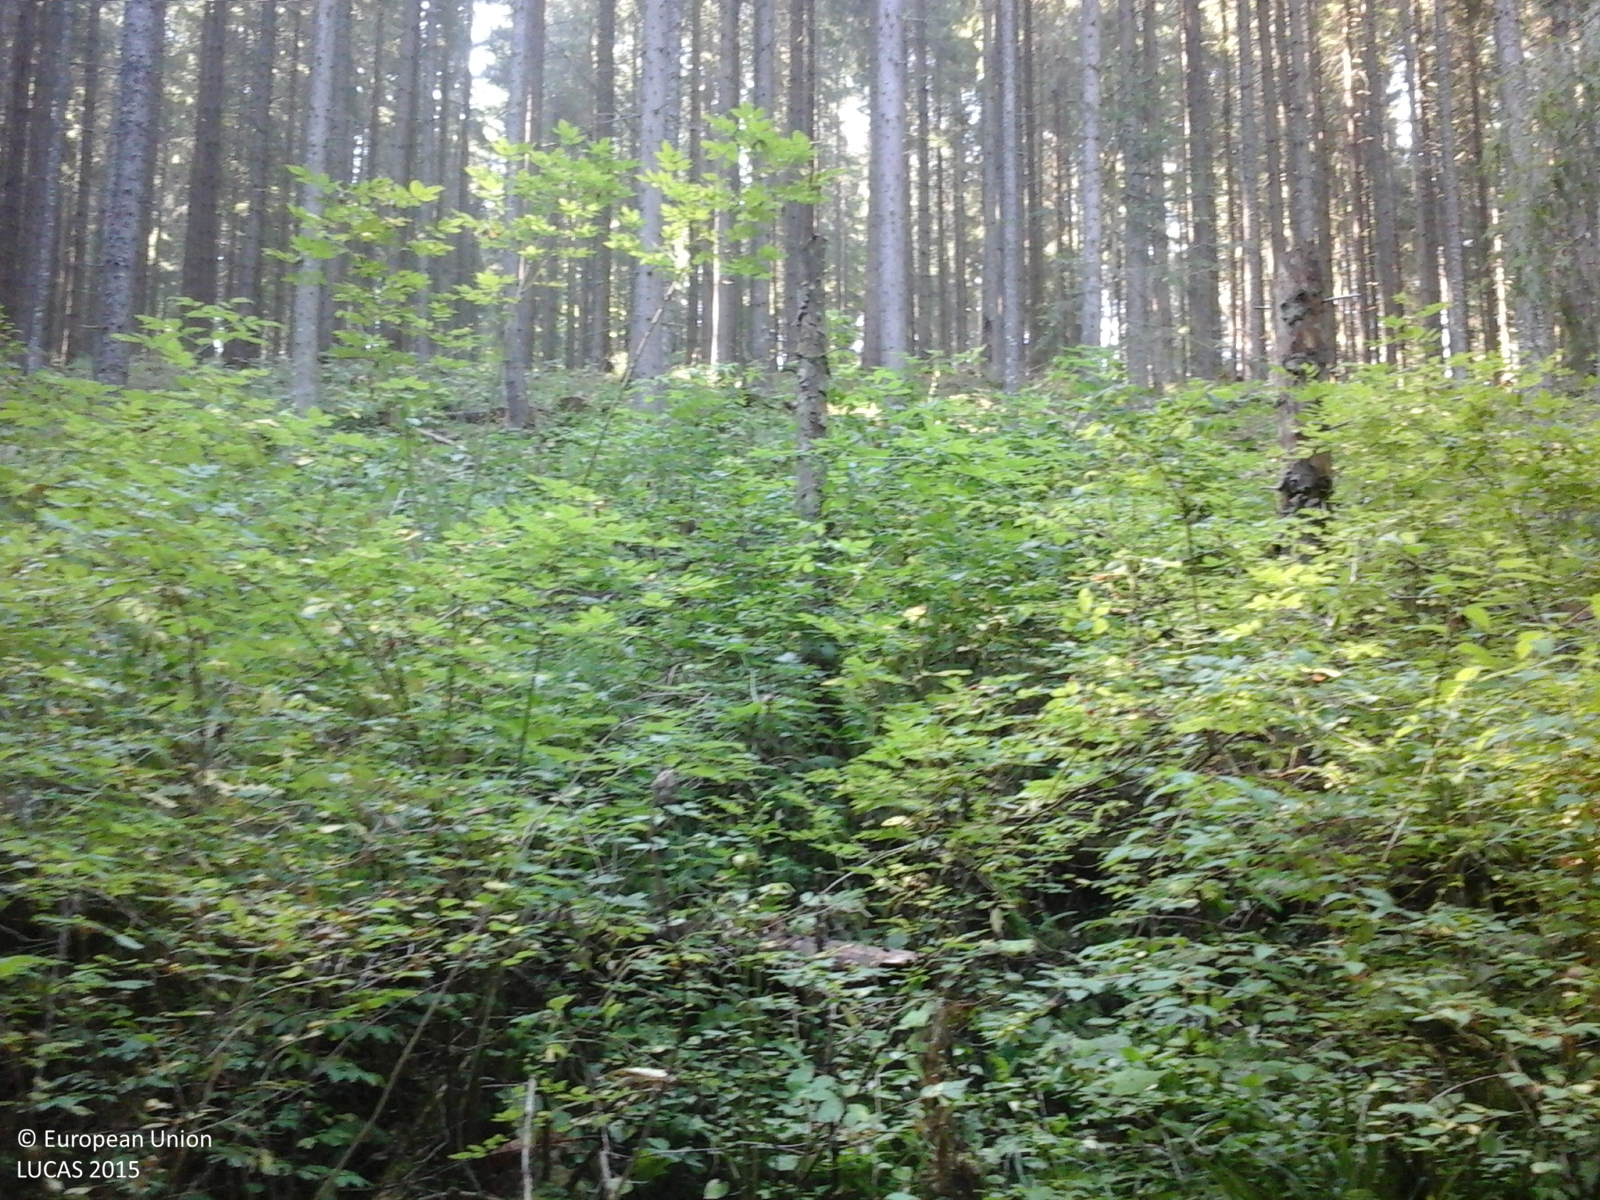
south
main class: Woodland
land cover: Spruce dominated coniferous woodland
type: alpine coniferous forest
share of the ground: > 75 %
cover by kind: coniferous forest trees 100 %
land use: Forestry
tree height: > 5 m
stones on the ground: < 10 %
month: September
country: RO
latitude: 47.2487
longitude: 25.1011
